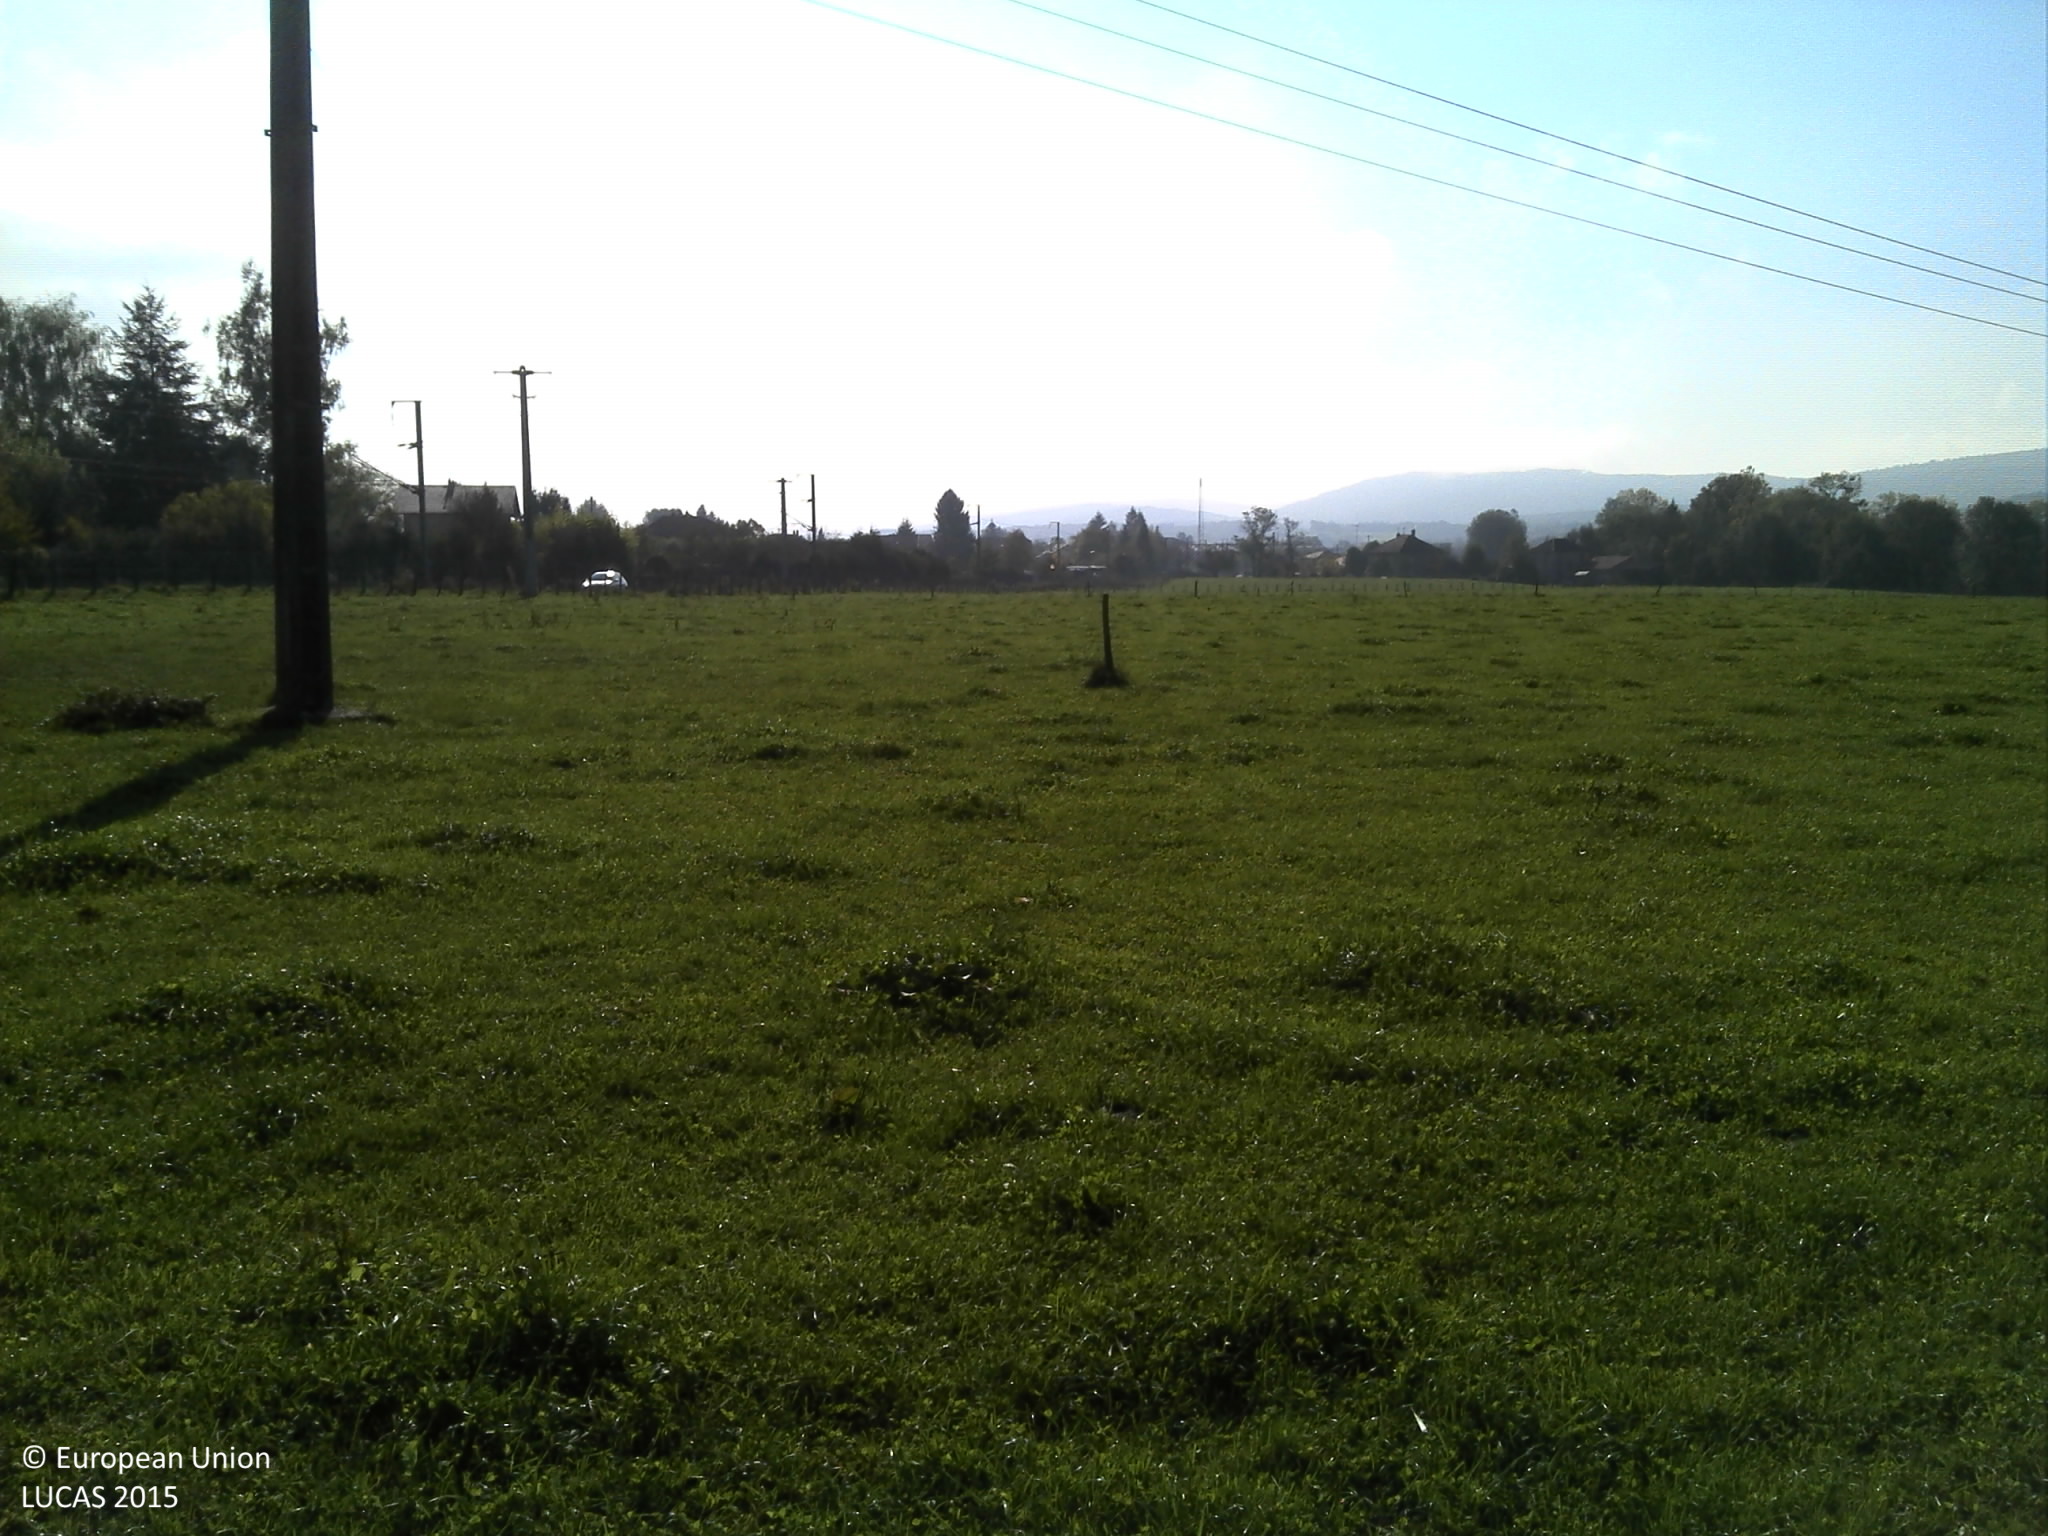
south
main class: Grassland
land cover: Grassland without tree/shrub cover
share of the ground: > 75 %
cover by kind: herbaceous plants 100 %
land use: Agriculture (excluding fallow land and kitchen gardens)
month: October
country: FR
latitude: 46.1983
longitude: 5.4028
